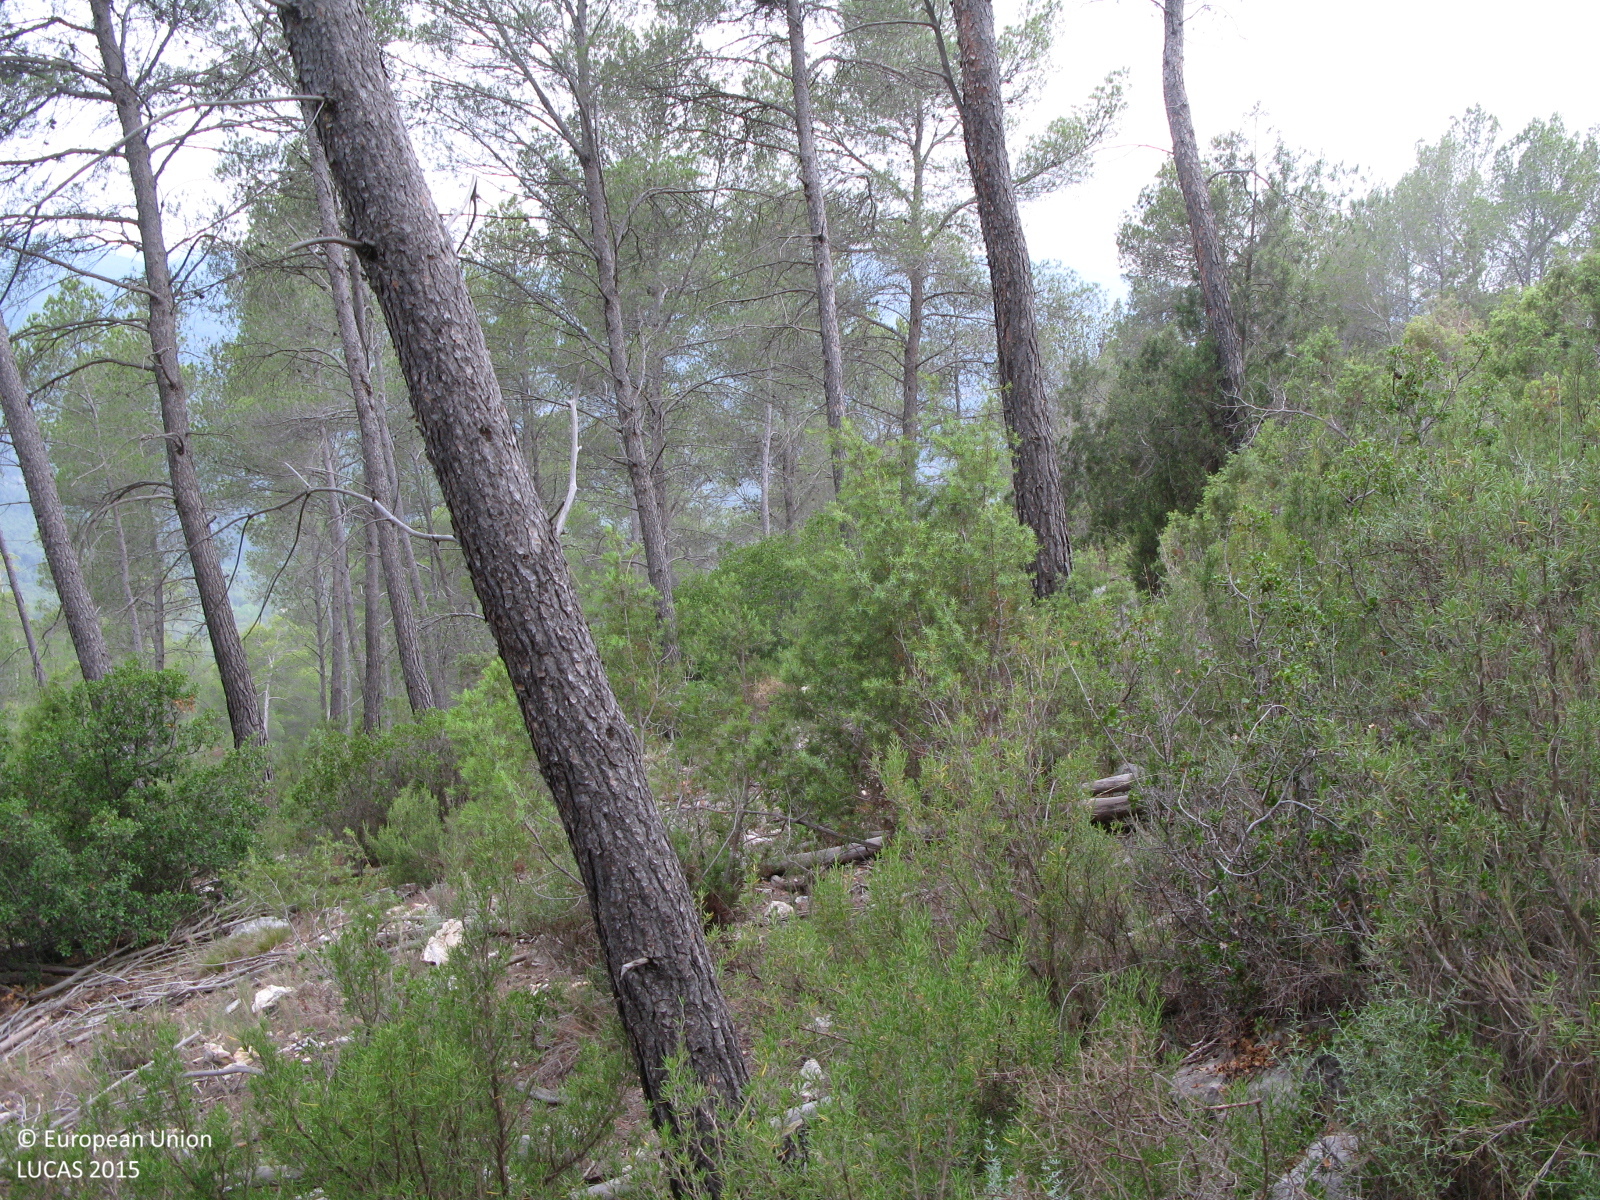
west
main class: Woodland
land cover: Pine dominated coniferous woodland
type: coniferous forest of the mediterranean region
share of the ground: 50 - 75 %
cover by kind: coniferous forest trees 50 %, shrubs 30 %, herbaceous plants 15 %, consolidated bare surface 5 %
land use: Forestry
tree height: > 5 m
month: June
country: ES
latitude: 39.8852
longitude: -1.1501
